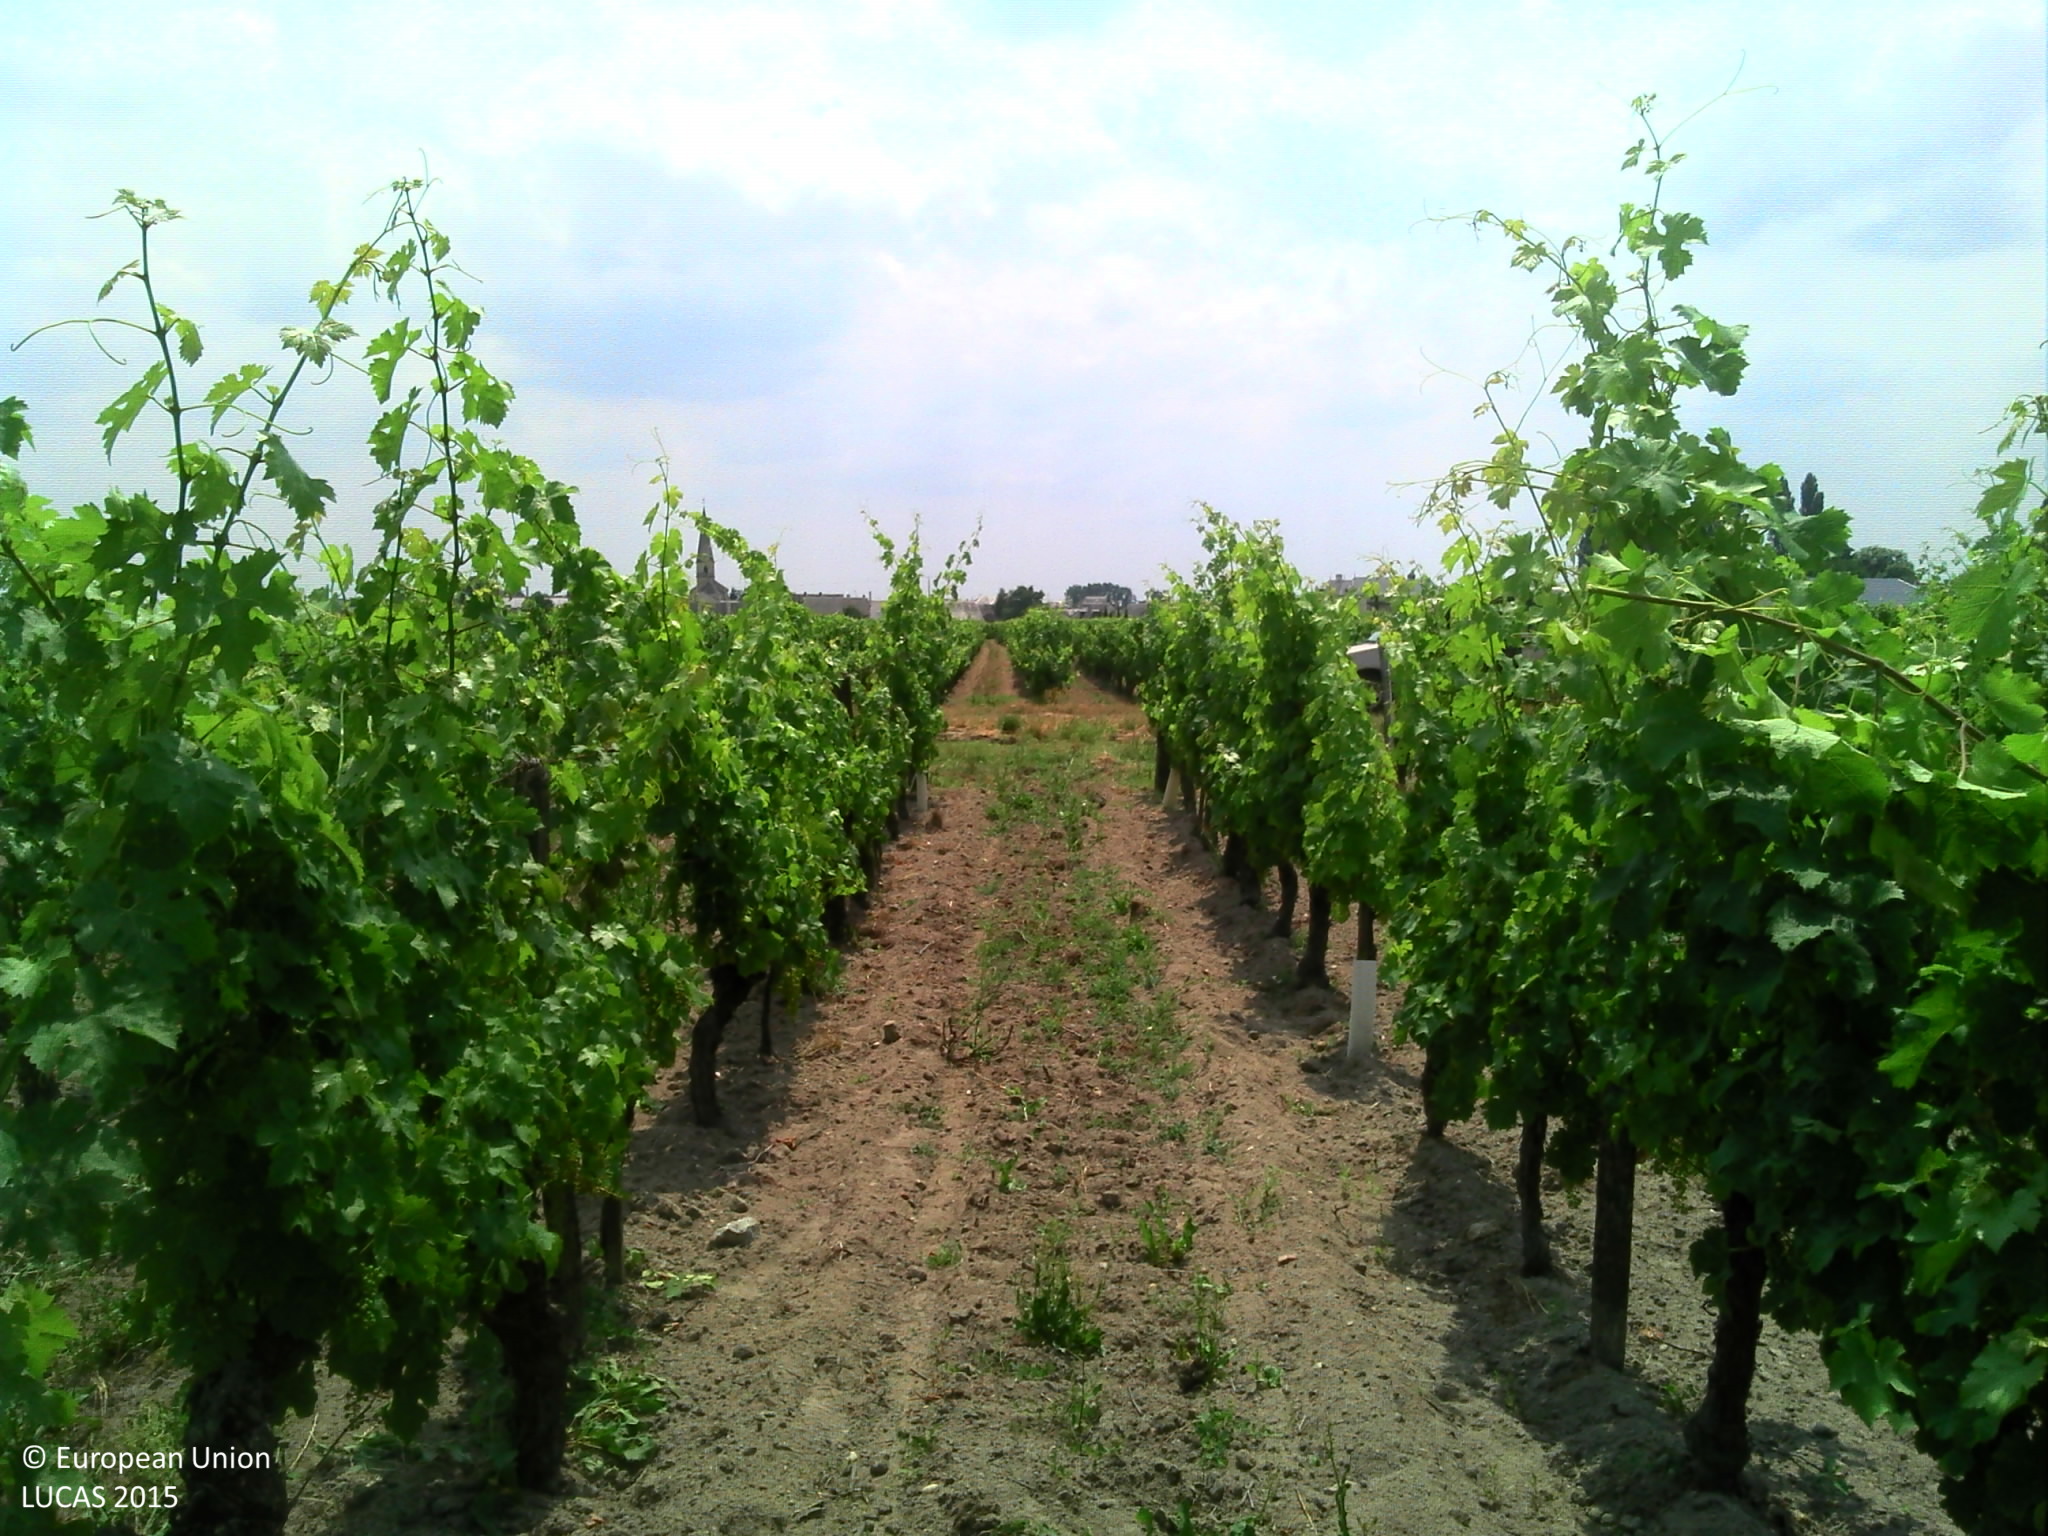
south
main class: Cropland
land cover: Vineyards
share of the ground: 25 - 50 %
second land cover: Other bare soil
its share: > 75 %
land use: Agriculture (excluding fallow land and kitchen gardens)
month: July
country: FR
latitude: 47.2897
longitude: 0.1252
